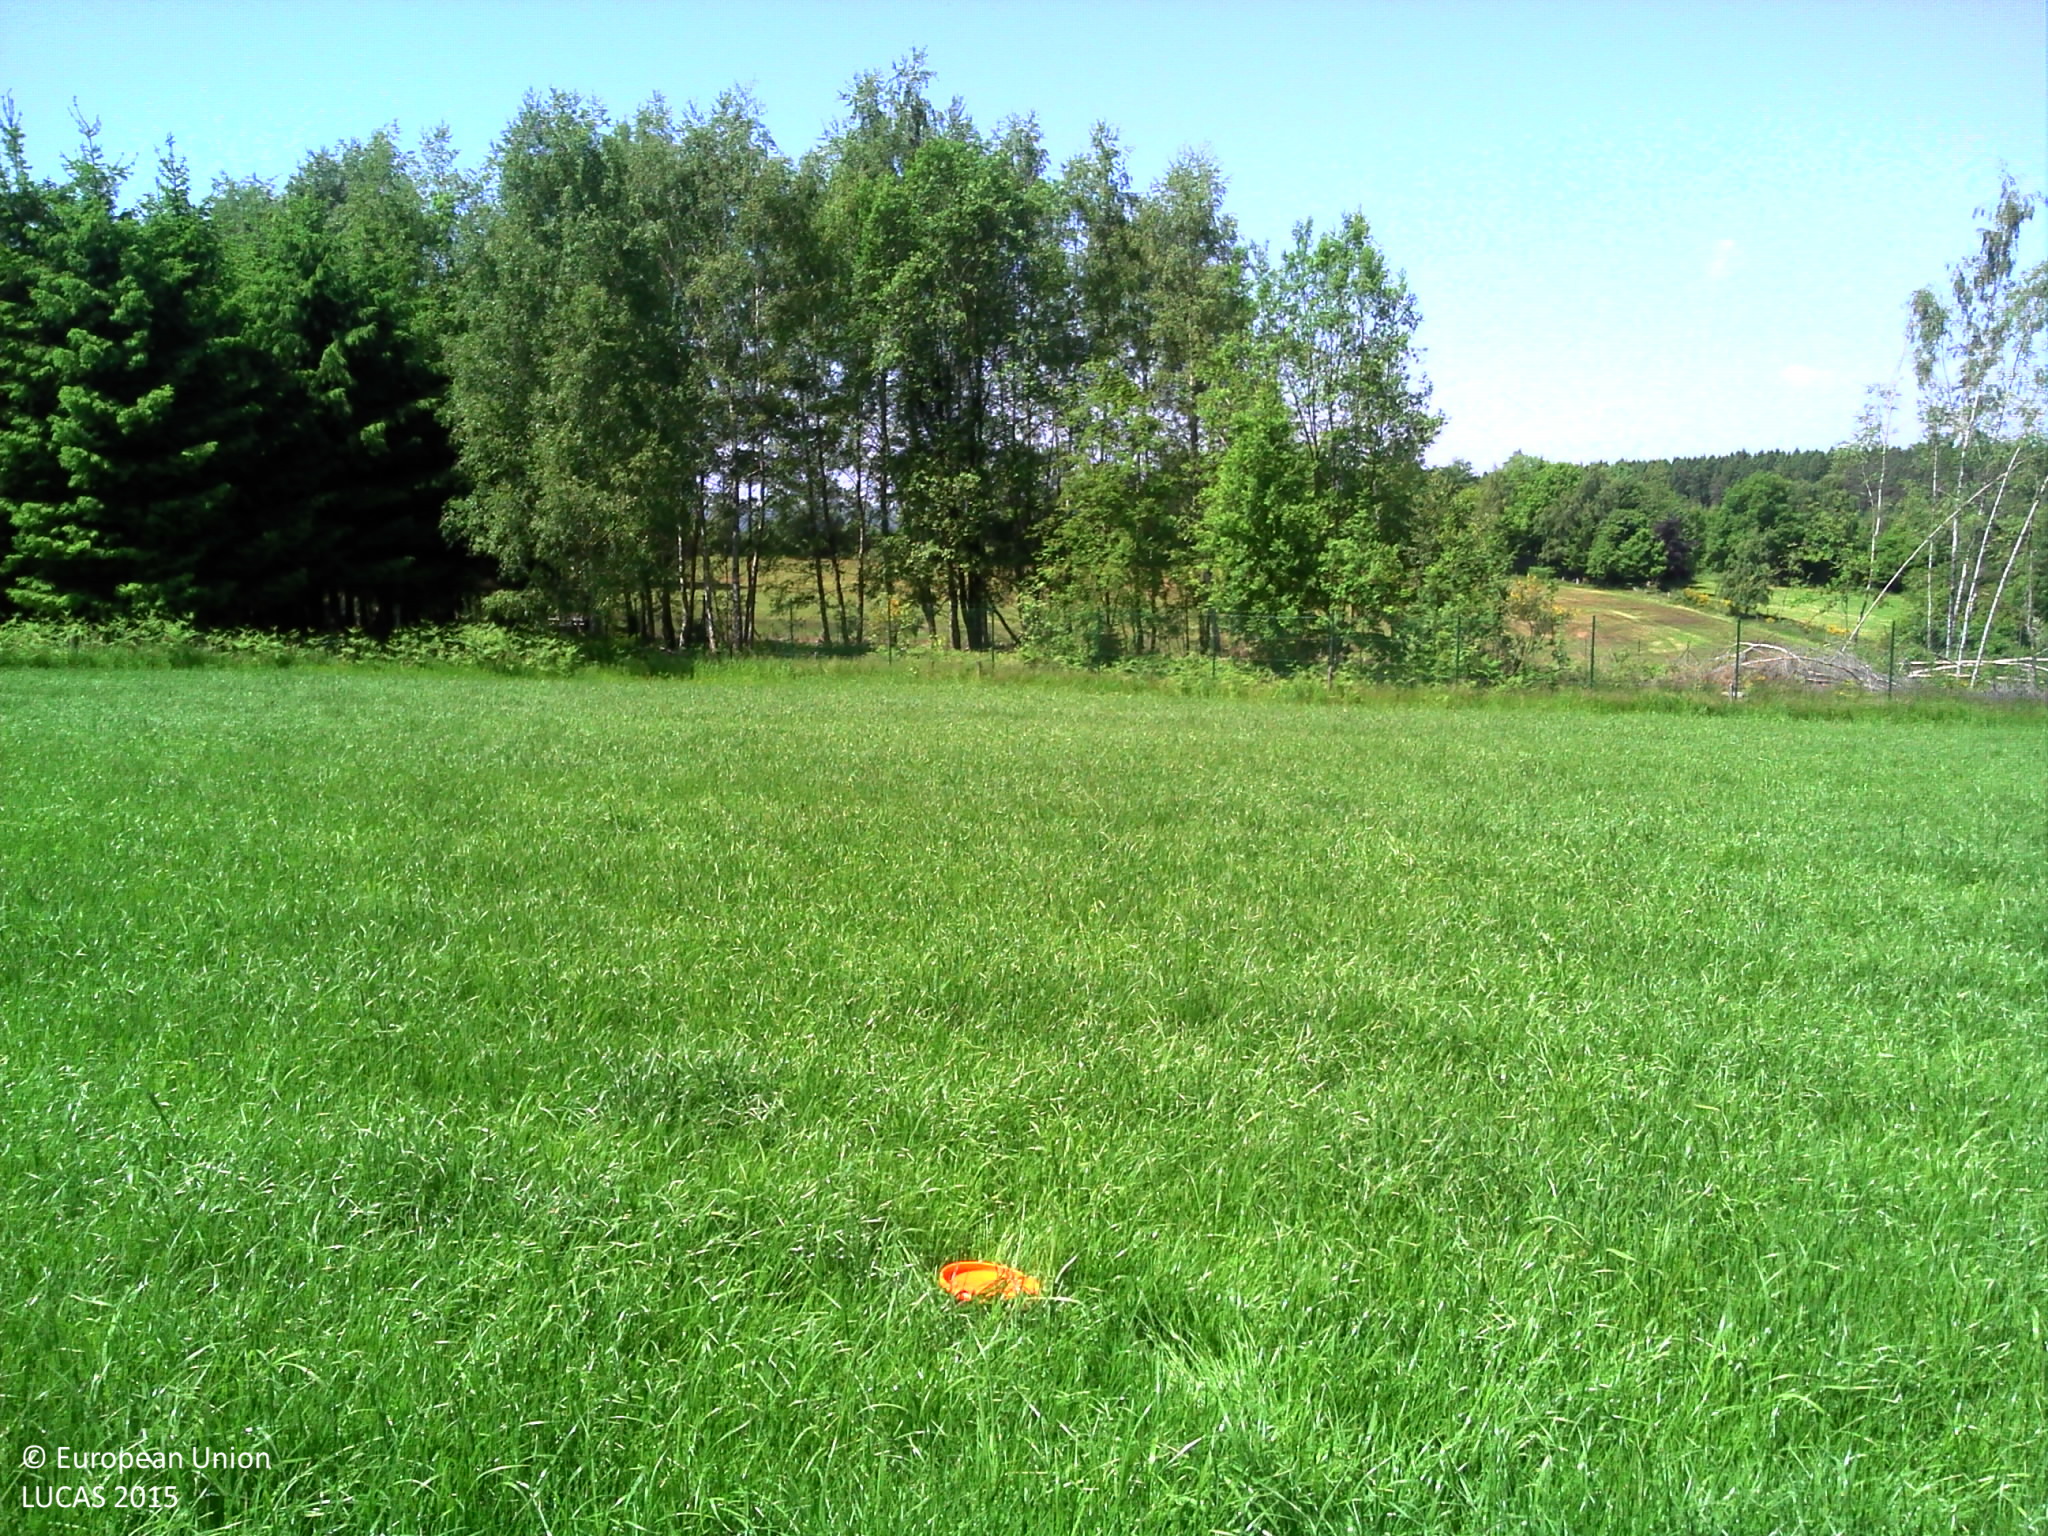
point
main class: Grassland
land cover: Grassland without tree/shrub cover
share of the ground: > 75 %
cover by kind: herbaceous plants 100 %
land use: Agriculture (excluding fallow land and kitchen gardens)
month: June
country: BE
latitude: 50.4834
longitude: 5.7565
